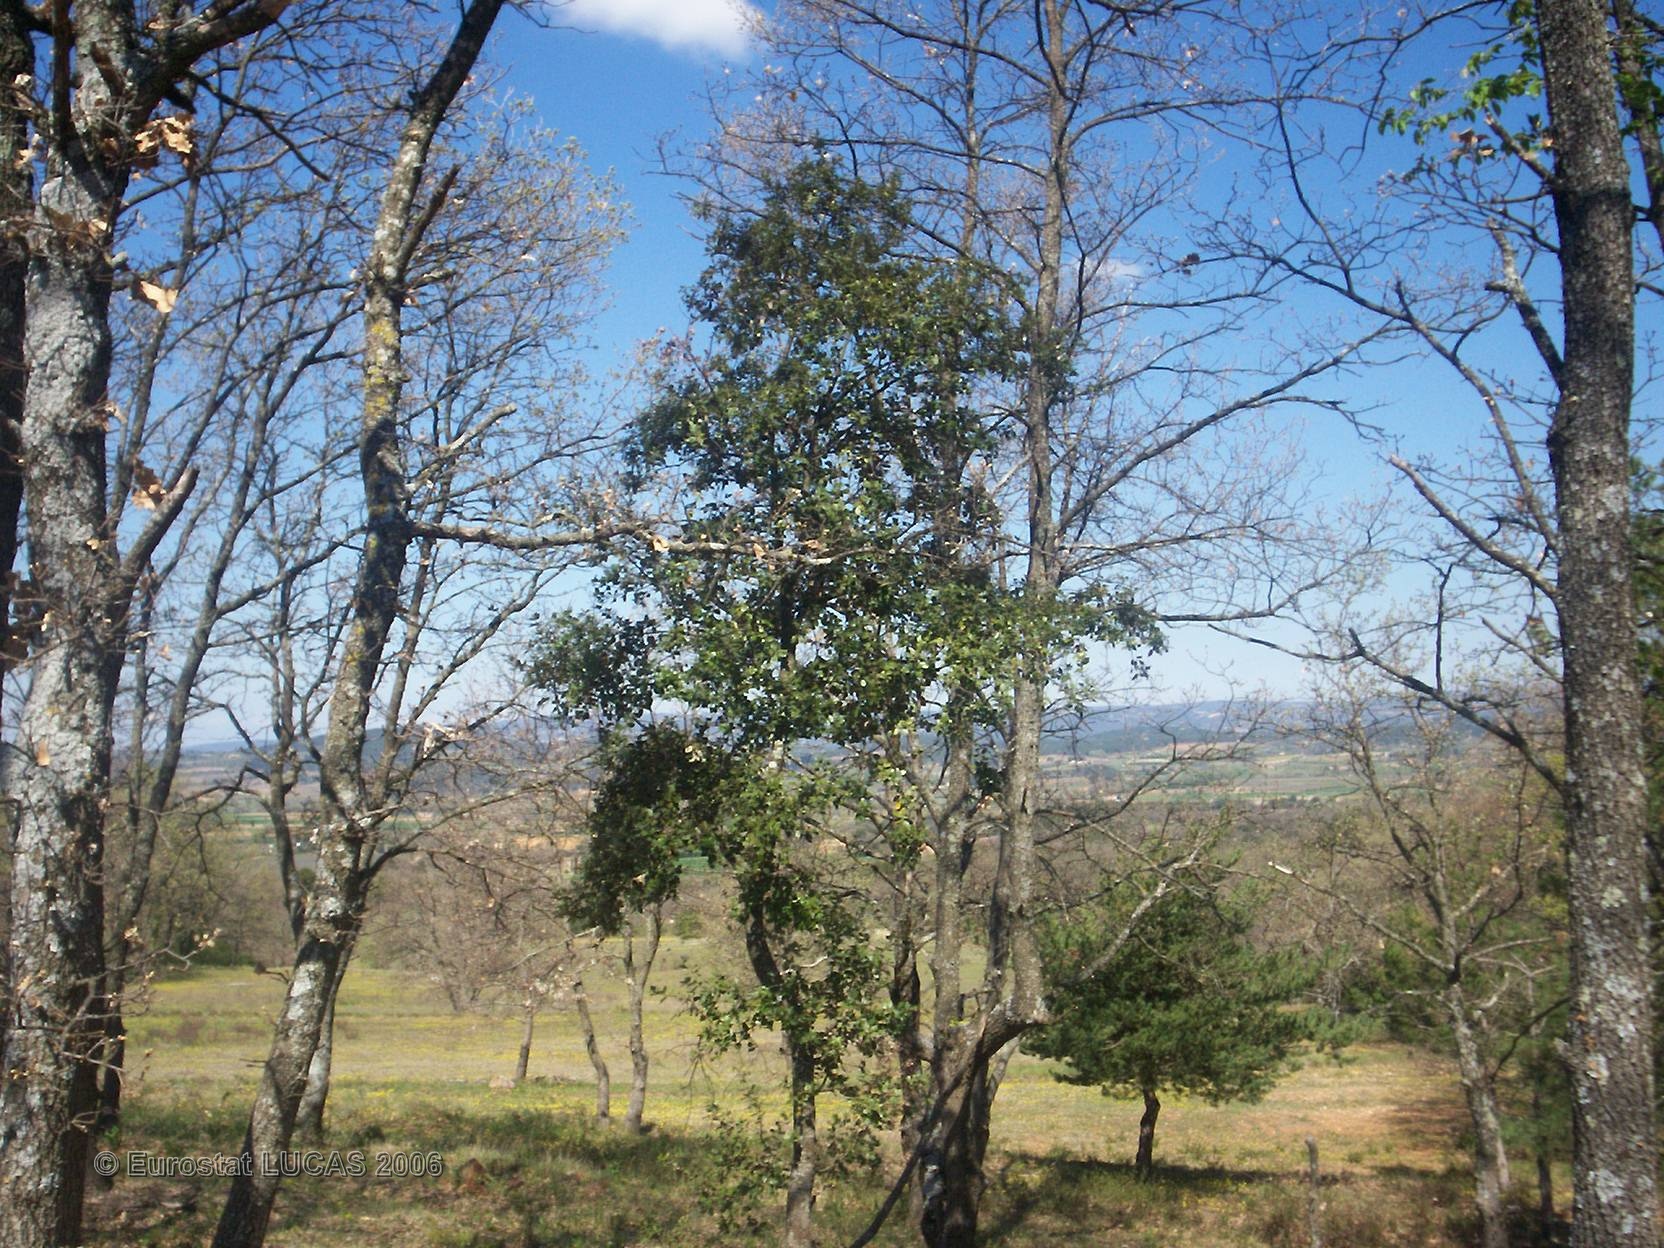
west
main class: Woodland
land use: Forestry
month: April
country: FR
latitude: 43.8475
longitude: 5.3193
